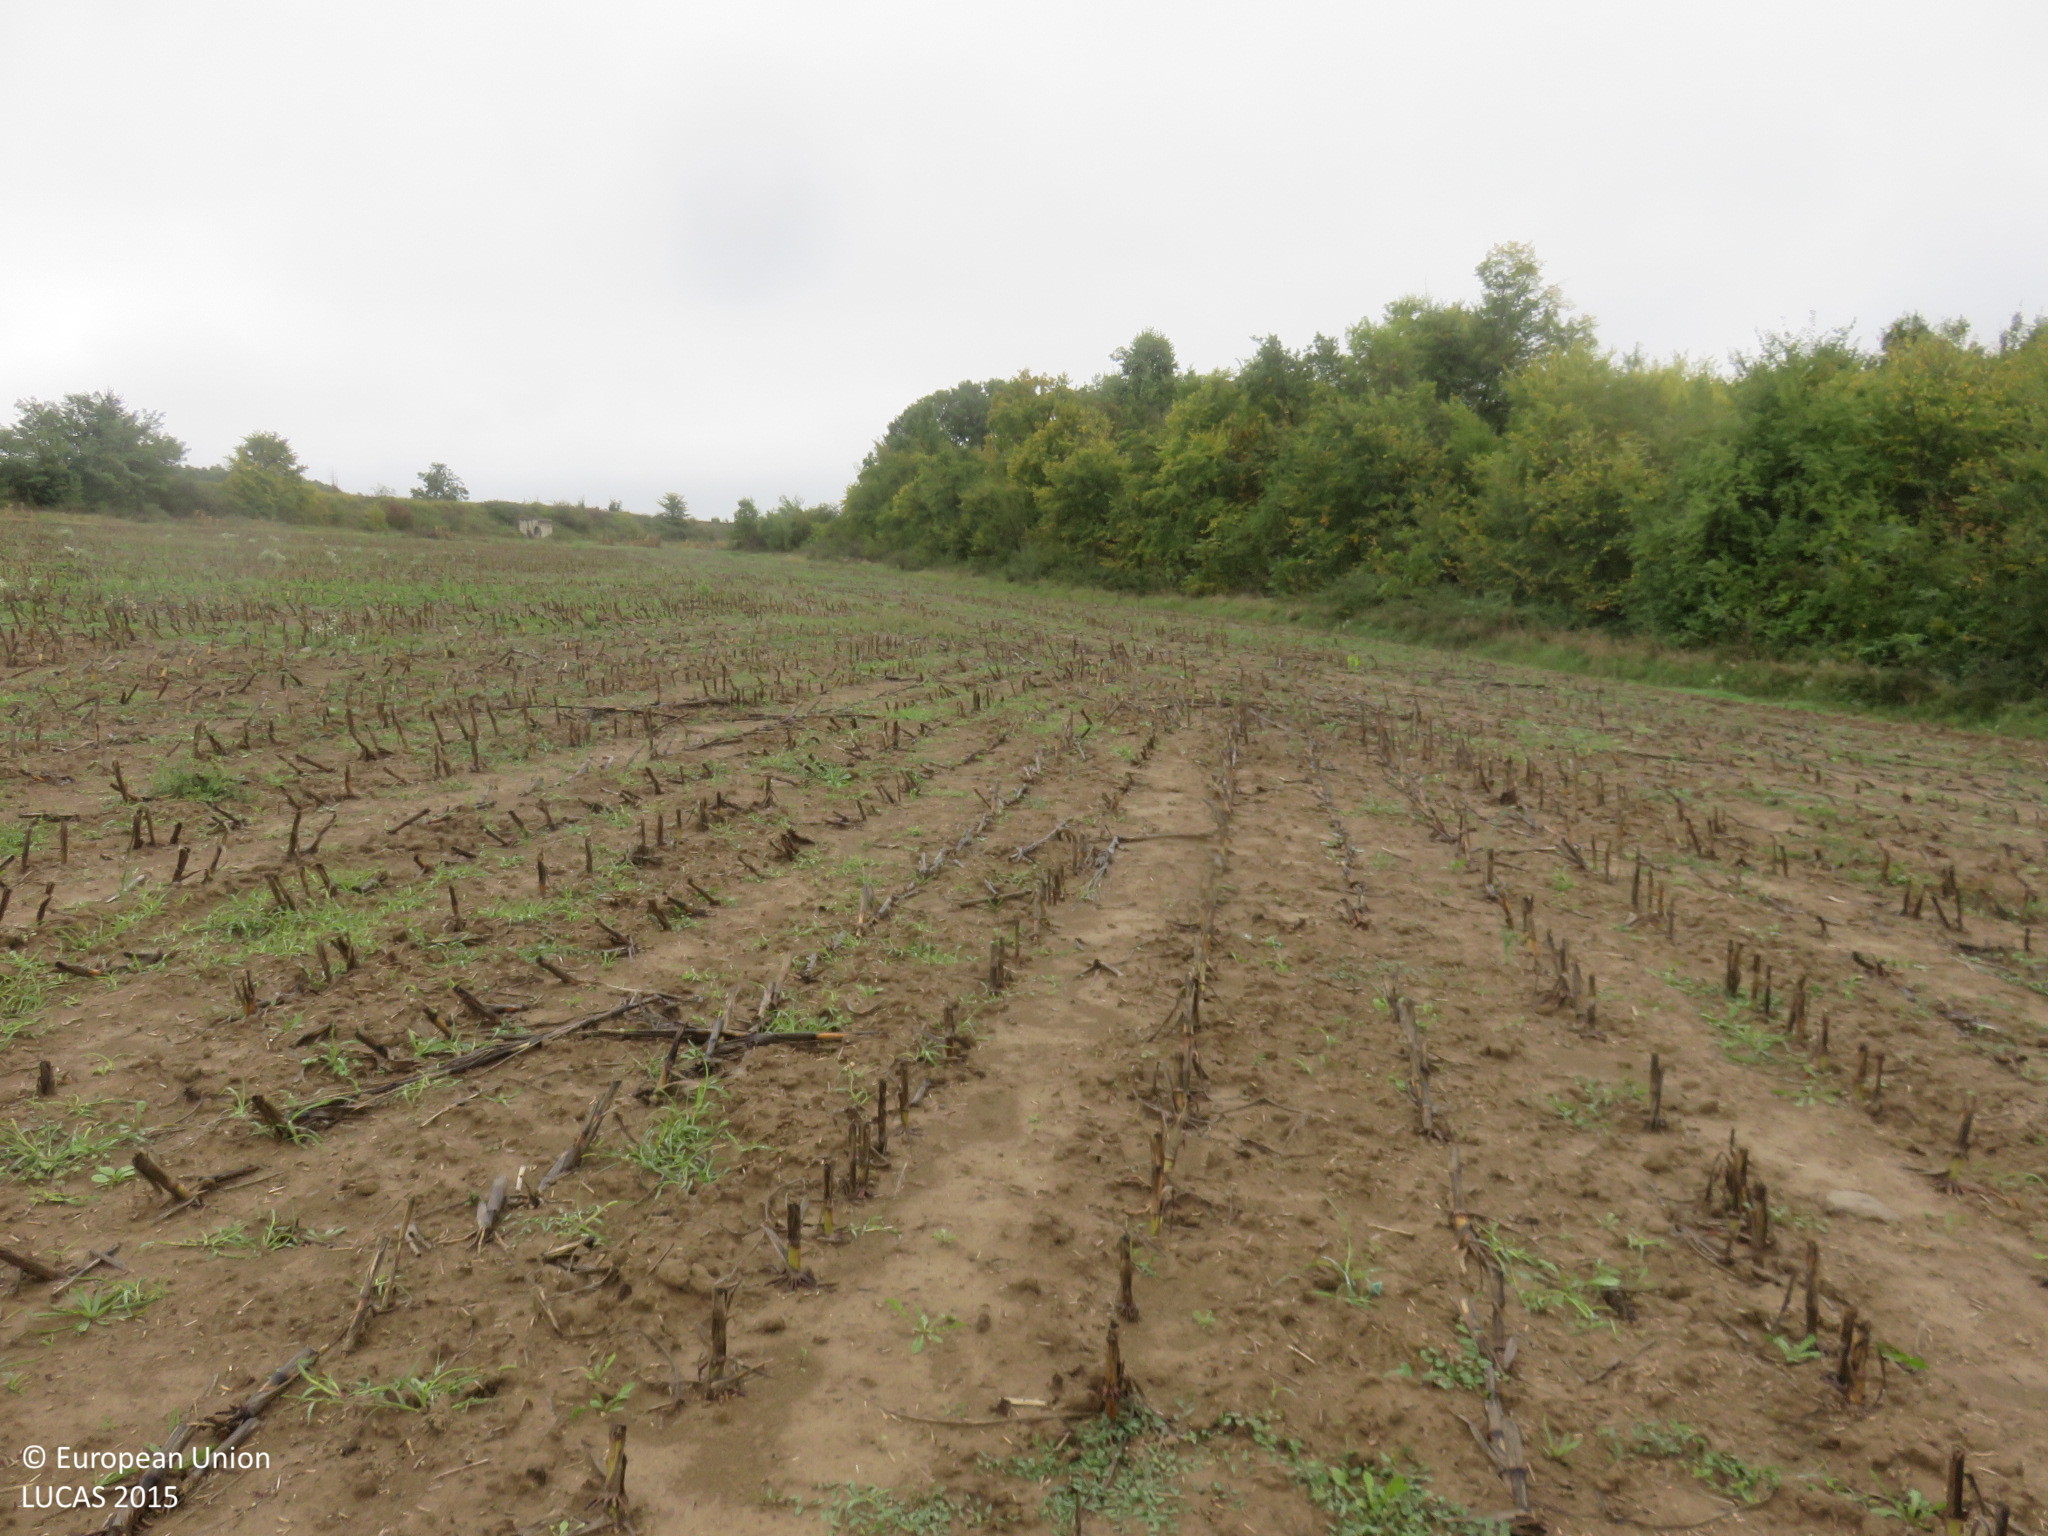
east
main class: Cropland
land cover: Maize
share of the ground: < 10 %
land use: Agriculture (excluding fallow land and kitchen gardens)
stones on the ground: < 10 %
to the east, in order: Maize; Grass margins; Broadleaved woodland; Maize; Grassland with sparse tree/shrub cover
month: October
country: BG
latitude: 43.0023
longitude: 25.4457
